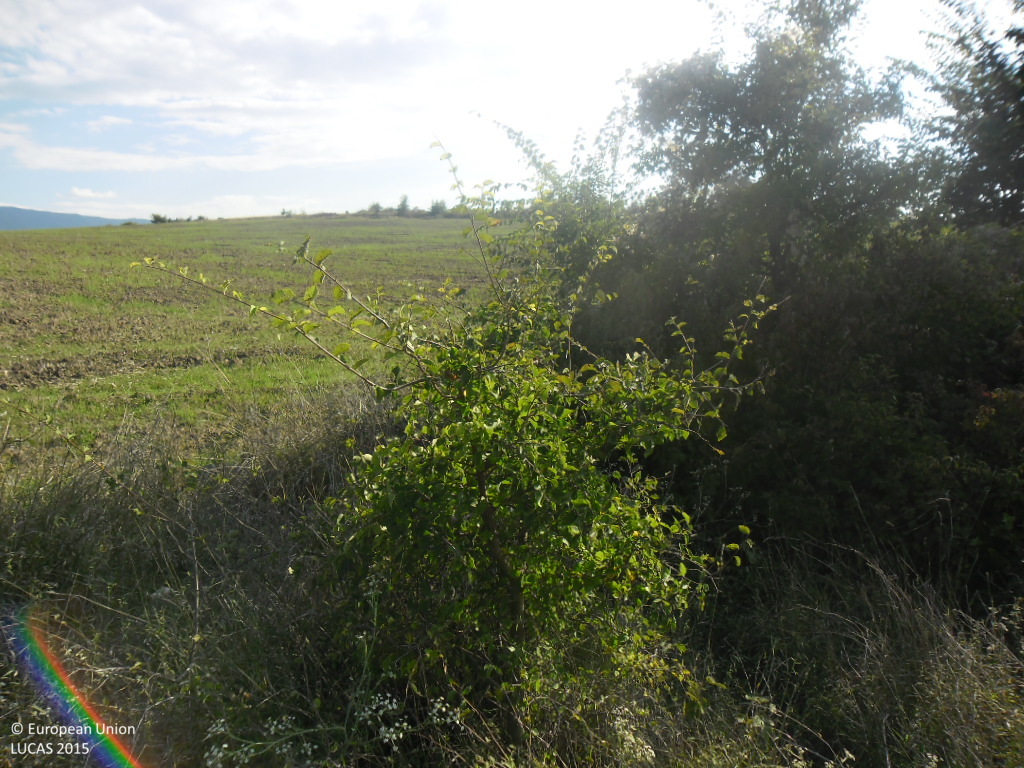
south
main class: Shrubland
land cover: Shrubland with sparse tree cover
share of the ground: > 75 %
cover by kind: shrubs 60 %, herbaceous plants 35 %, broadleaved forest trees 5 %
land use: Agriculture (excluding fallow land and kitchen gardens)
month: October
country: BG
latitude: 41.4315
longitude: 23.3888
